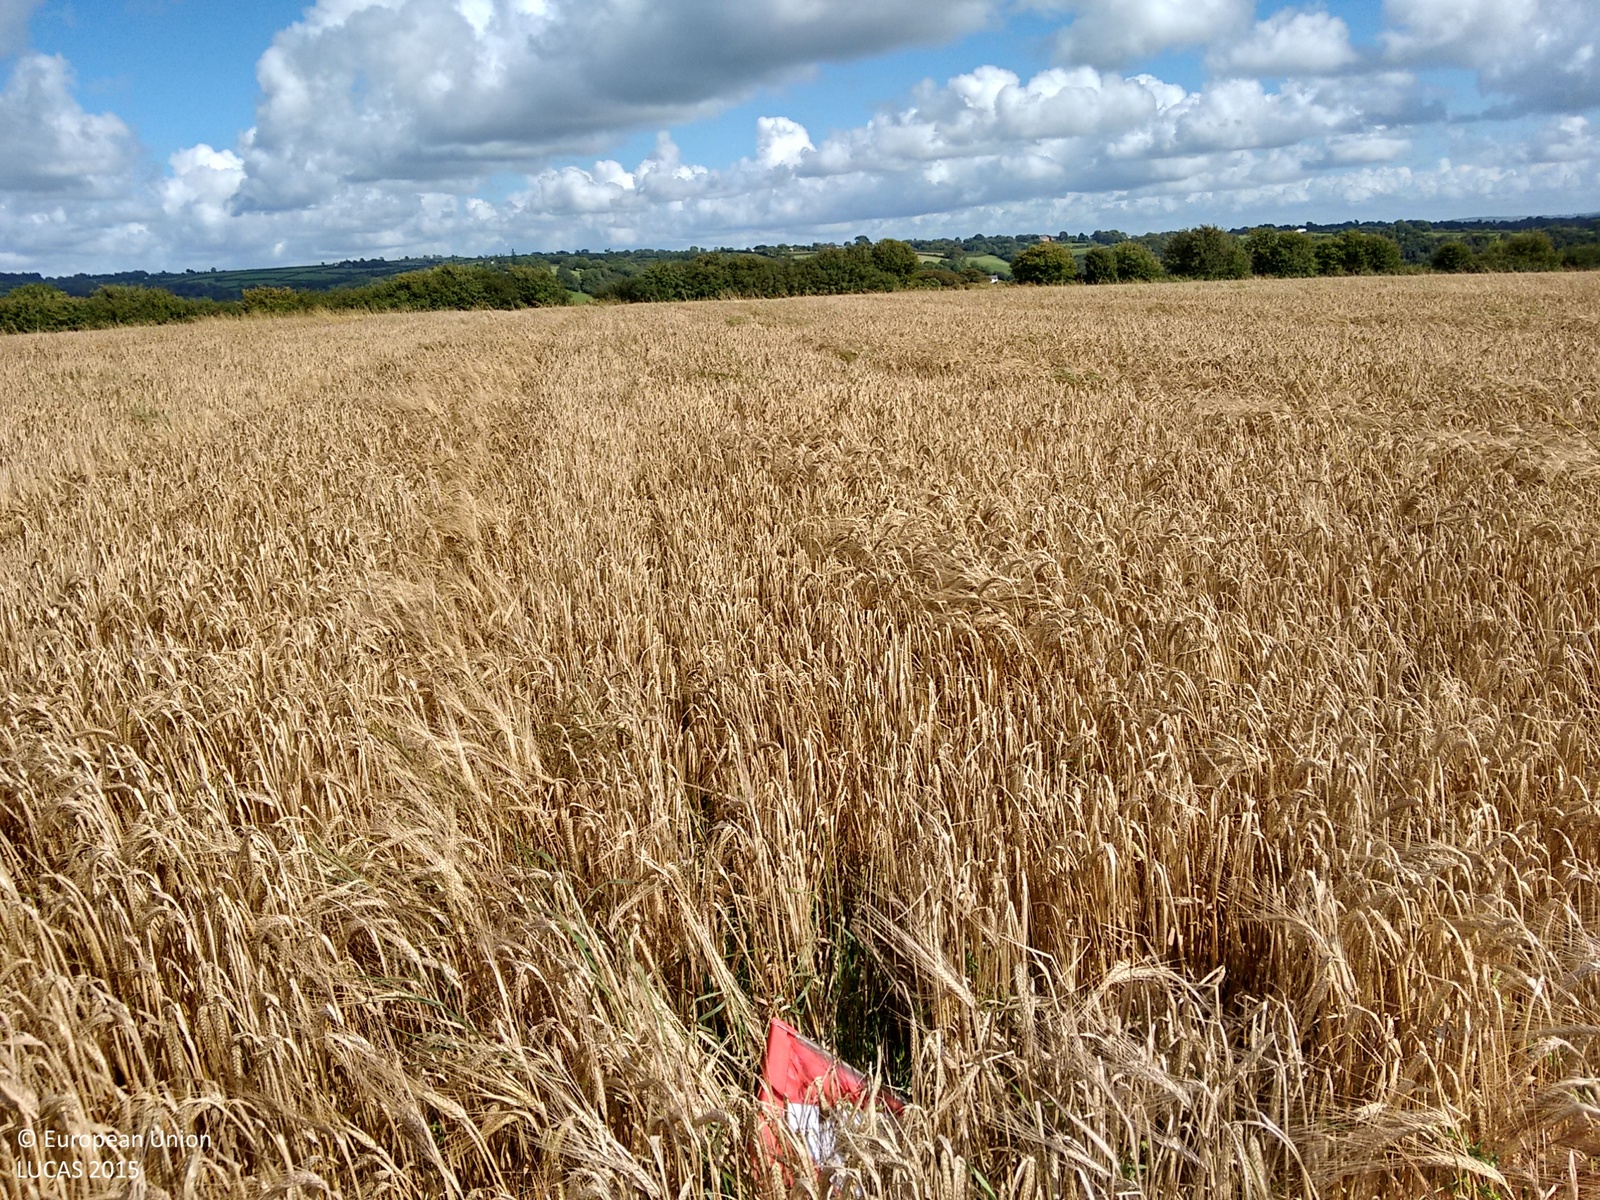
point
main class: Cropland
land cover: Barley
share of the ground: > 75 %
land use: Agriculture (excluding fallow land and kitchen gardens)
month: August
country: GB
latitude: 51.8678
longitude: -4.7652
